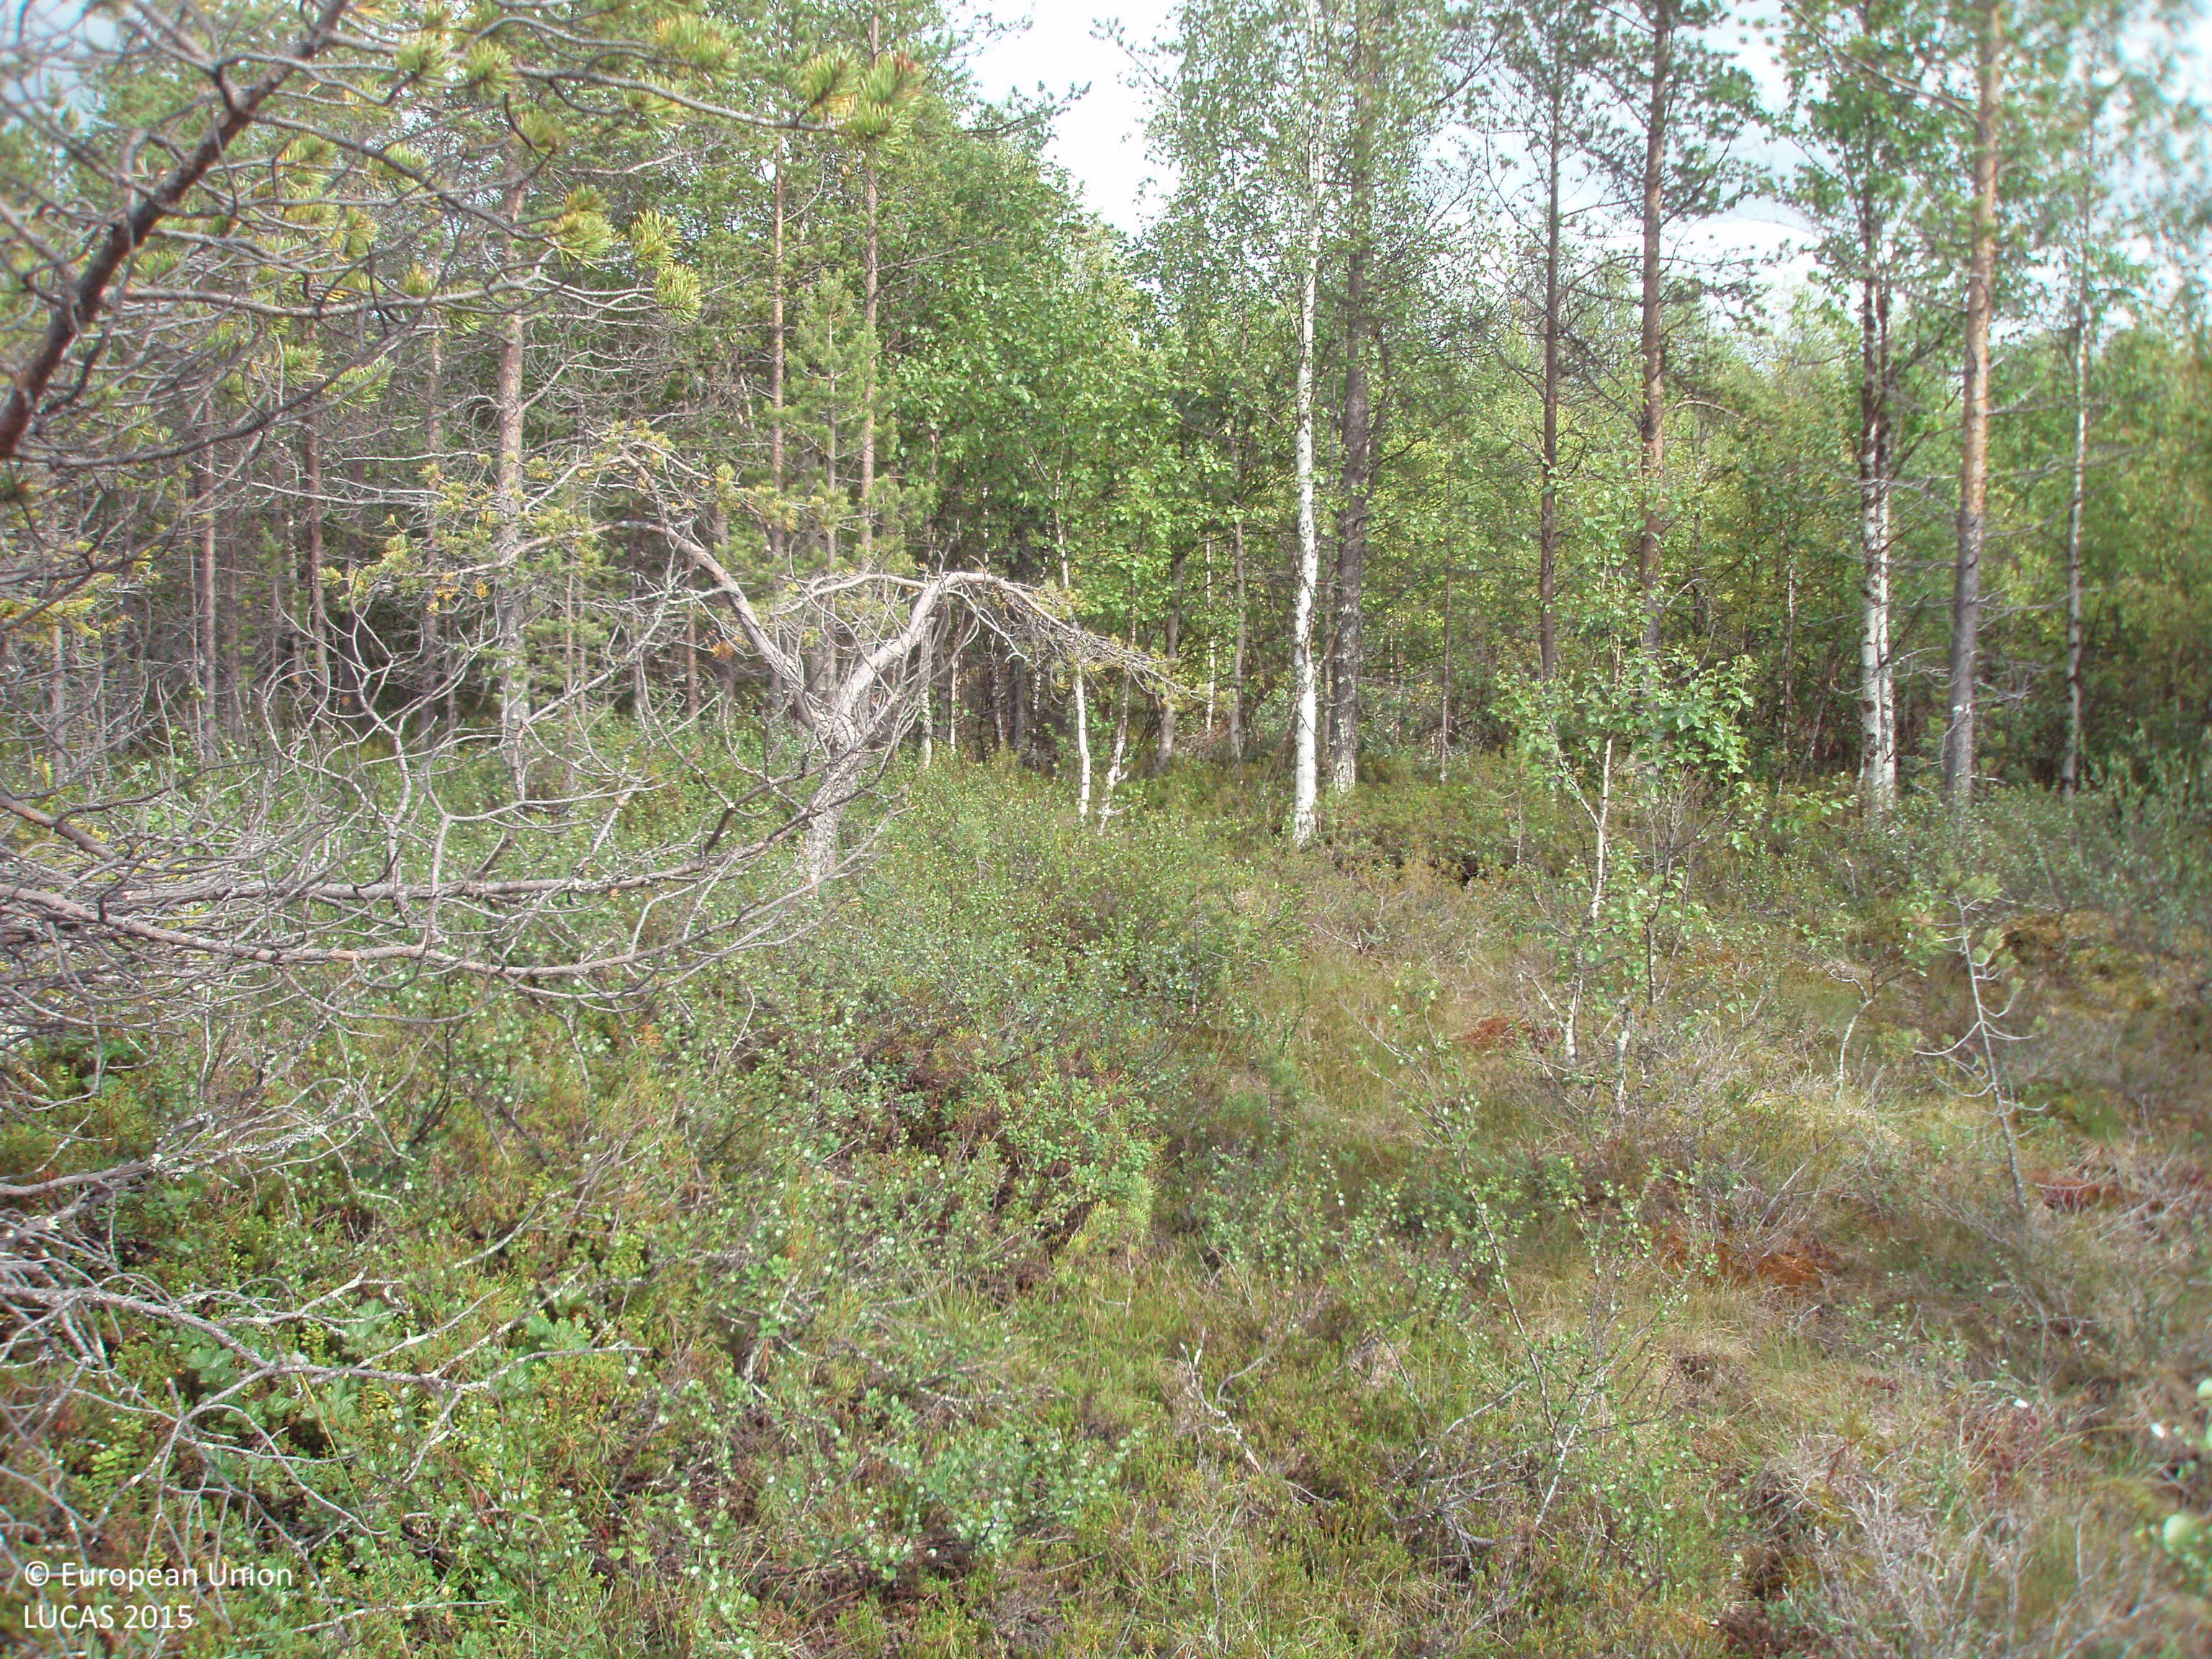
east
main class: Woodland
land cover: Pine dominated coniferous woodland
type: boreal forest
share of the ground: 10 - 25 %
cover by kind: shrubs 60 %, coniferous forest trees 20 %, lichens and mosses 15 %, herbaceous plants 5 %
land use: Semi-natural and natural areas not in use
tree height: > 5 m
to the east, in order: Pine dominated coniferous woodland; Pine dominated mixed woodland; Ditches and canals; Broadleaved woodland; Shrubland with sparse tree cover; Broadleaved woodland; Ditches and canals; Broadleaved woodland; Shrubland with sparse tree cover; Broadleaved woodland; Ditches and canals; Broadleaved woodland; Ditches and canals; Broadleaved woodland; Ditches and canals; Broadleaved woodland; Ditches and canals; Other mixed woodland; Pine dominated coniferous woodland; Pine dominated mixed woodland; Ditches and canals; Tracks
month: July
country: FI
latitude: 66.8802
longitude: 28.5591
